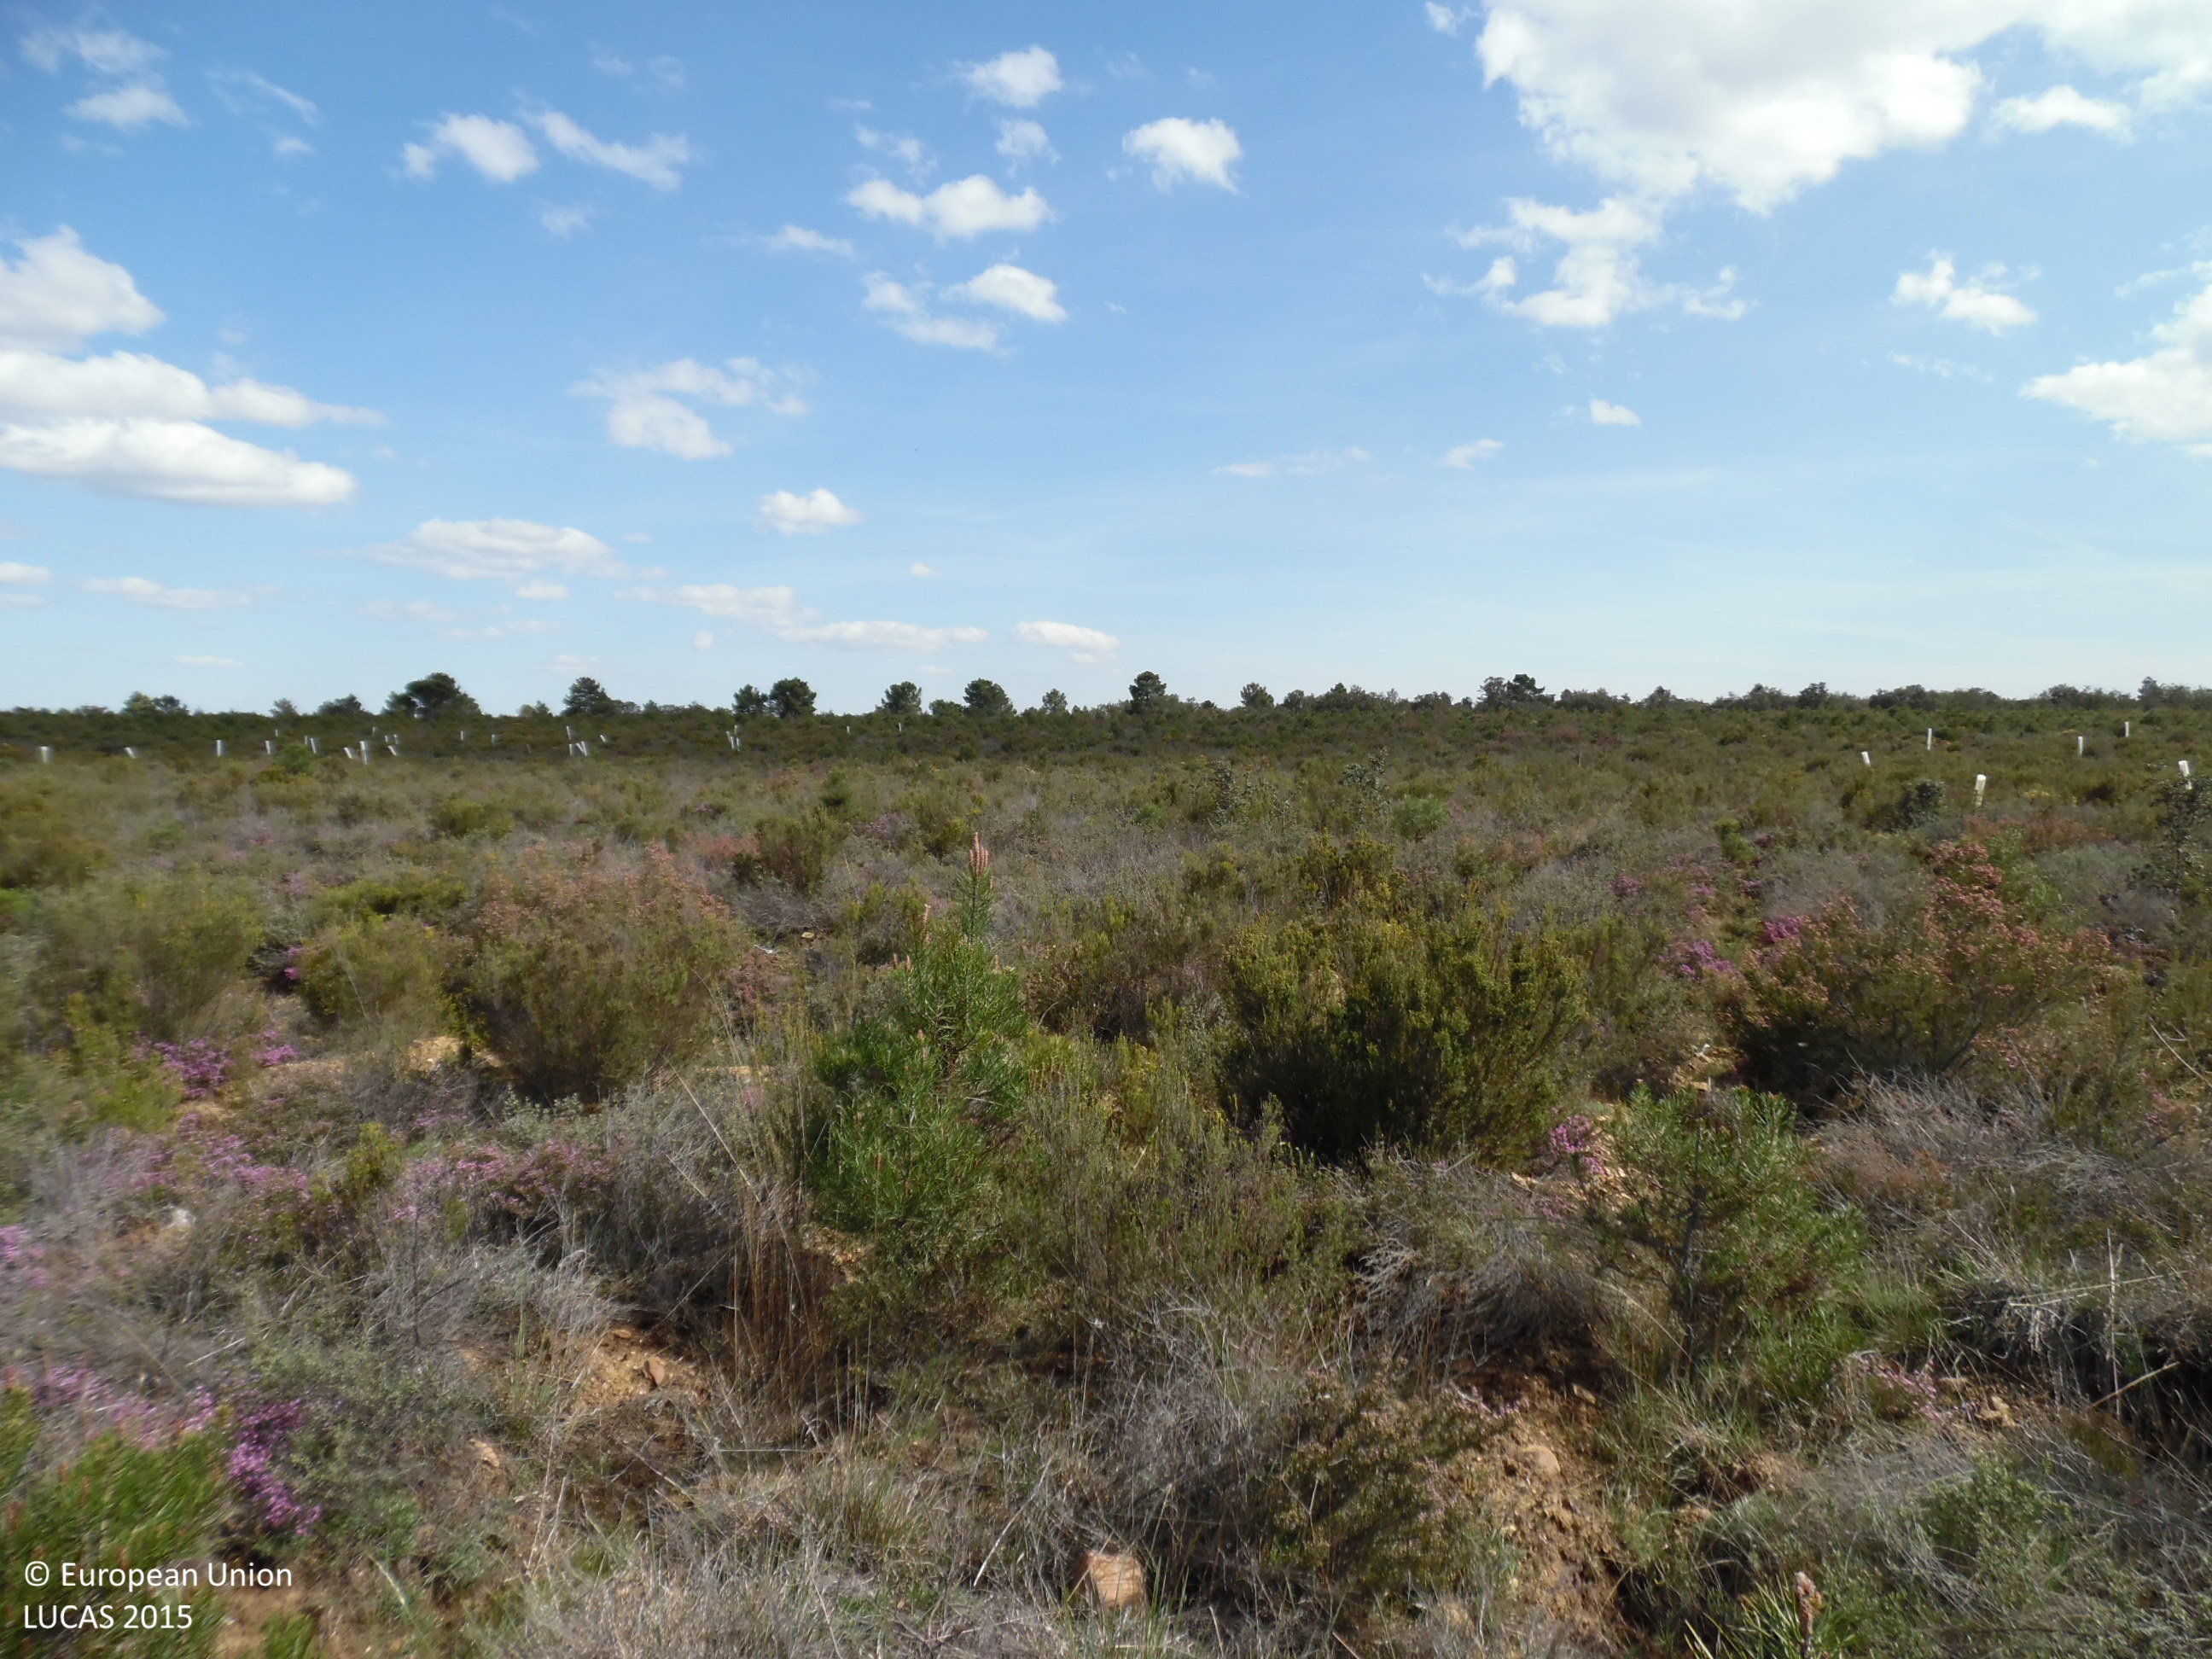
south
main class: Shrubland
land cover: Shrubland with sparse tree cover
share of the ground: > 75 %
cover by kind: shrubs 95 %, coniferous forest trees 5 %
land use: Forestry
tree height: < 5 m
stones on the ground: < 10 %
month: April
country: ES
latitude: 42.2755
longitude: -6.0976
